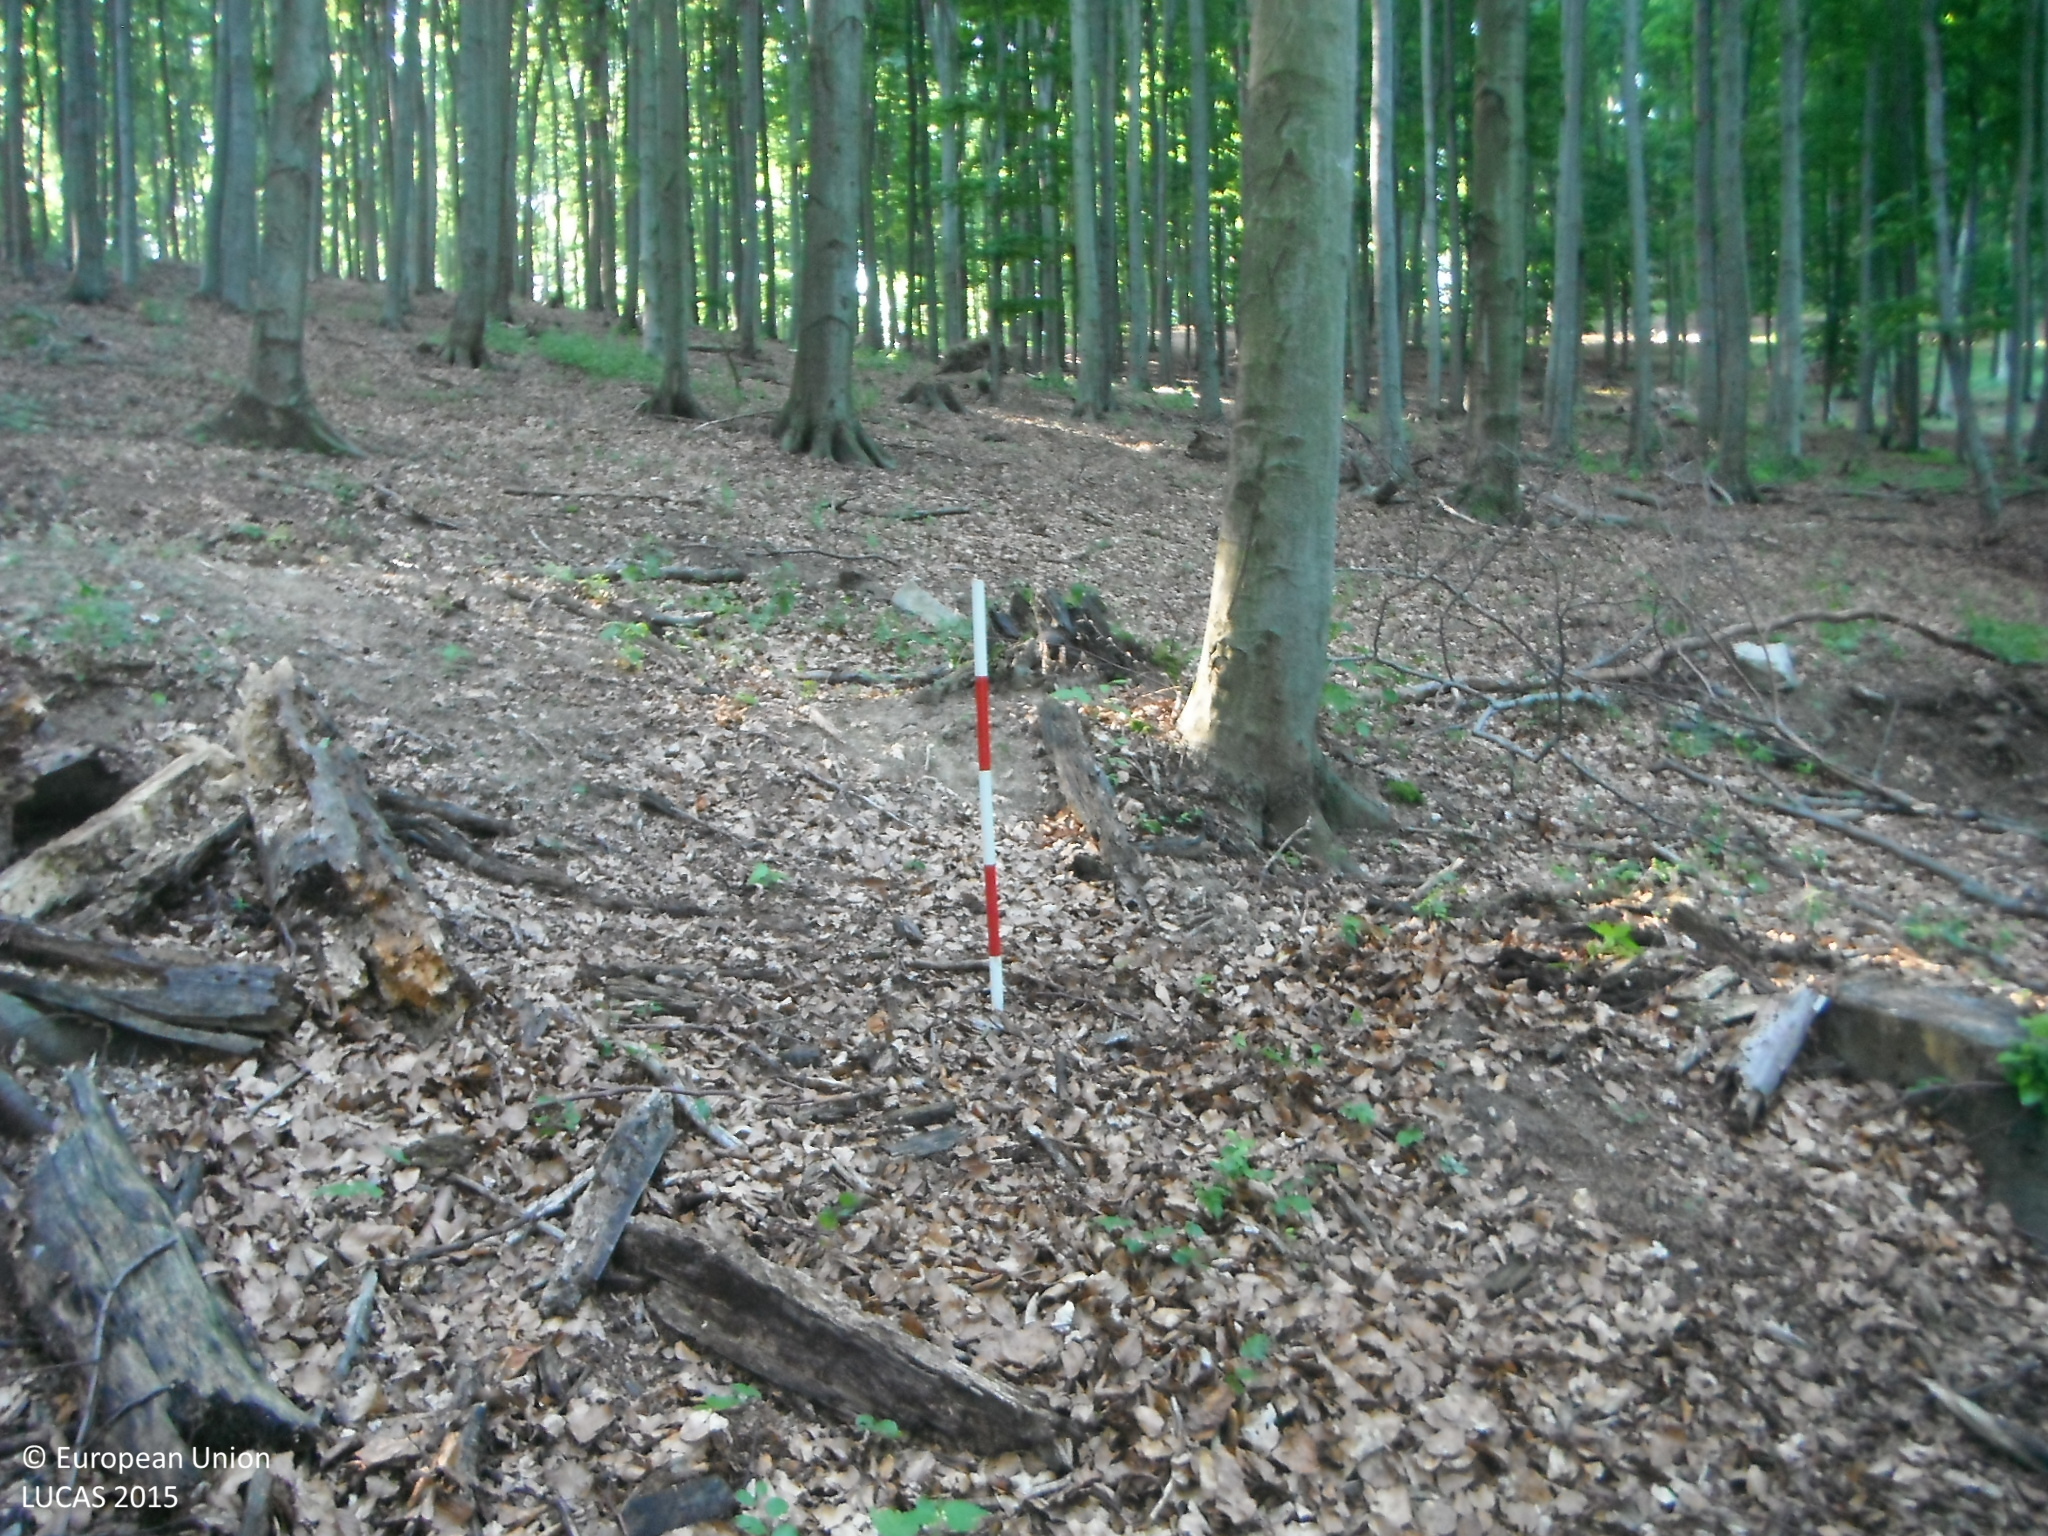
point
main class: Woodland
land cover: Broadleaved woodland
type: beech forest
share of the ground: > 75 %
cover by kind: broadleaved forest trees 80 %, shrubs 15 %, unconsolidated bare surface 5 %
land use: Forestry
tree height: > 5 m
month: June
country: SK
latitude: 48.5061
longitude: 18.3127
